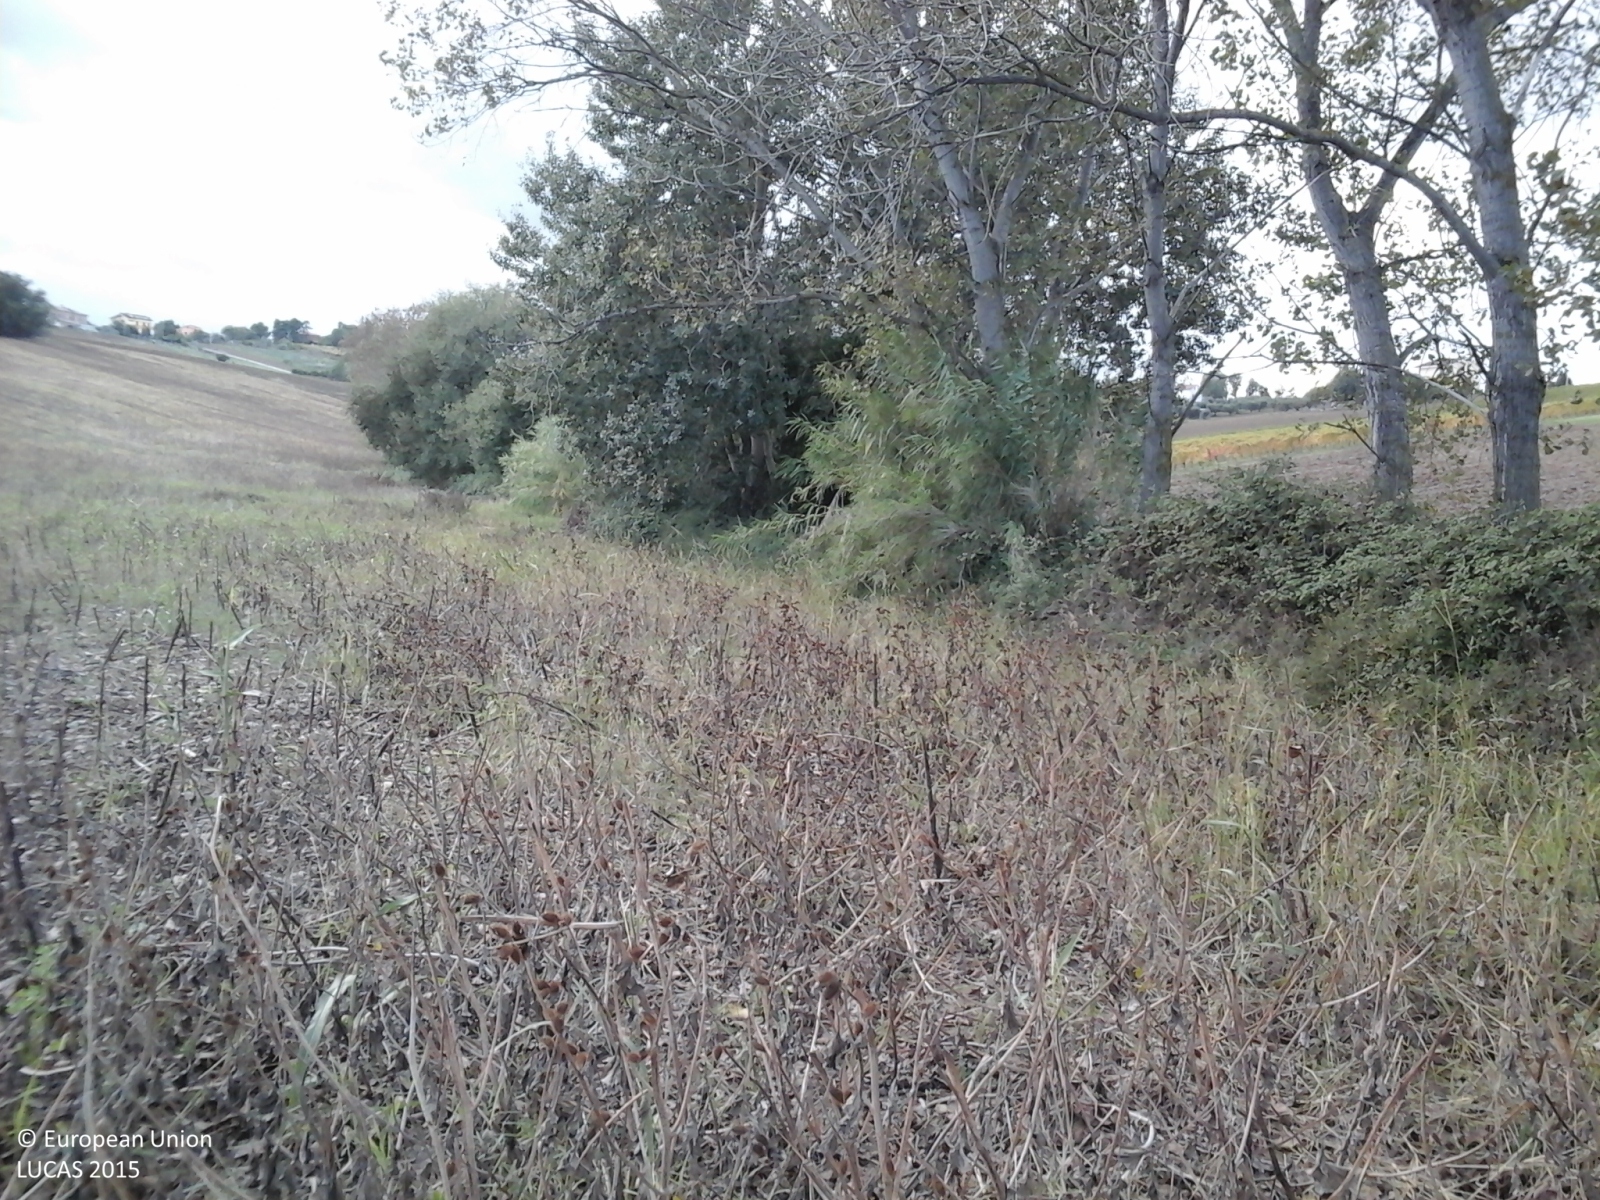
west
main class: Cropland
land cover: Sunflower
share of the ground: 25 - 50 %
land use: Agriculture (excluding fallow land and kitchen gardens)
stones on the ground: < 10 %
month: October
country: IT
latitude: 43.6489
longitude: 13.2777
